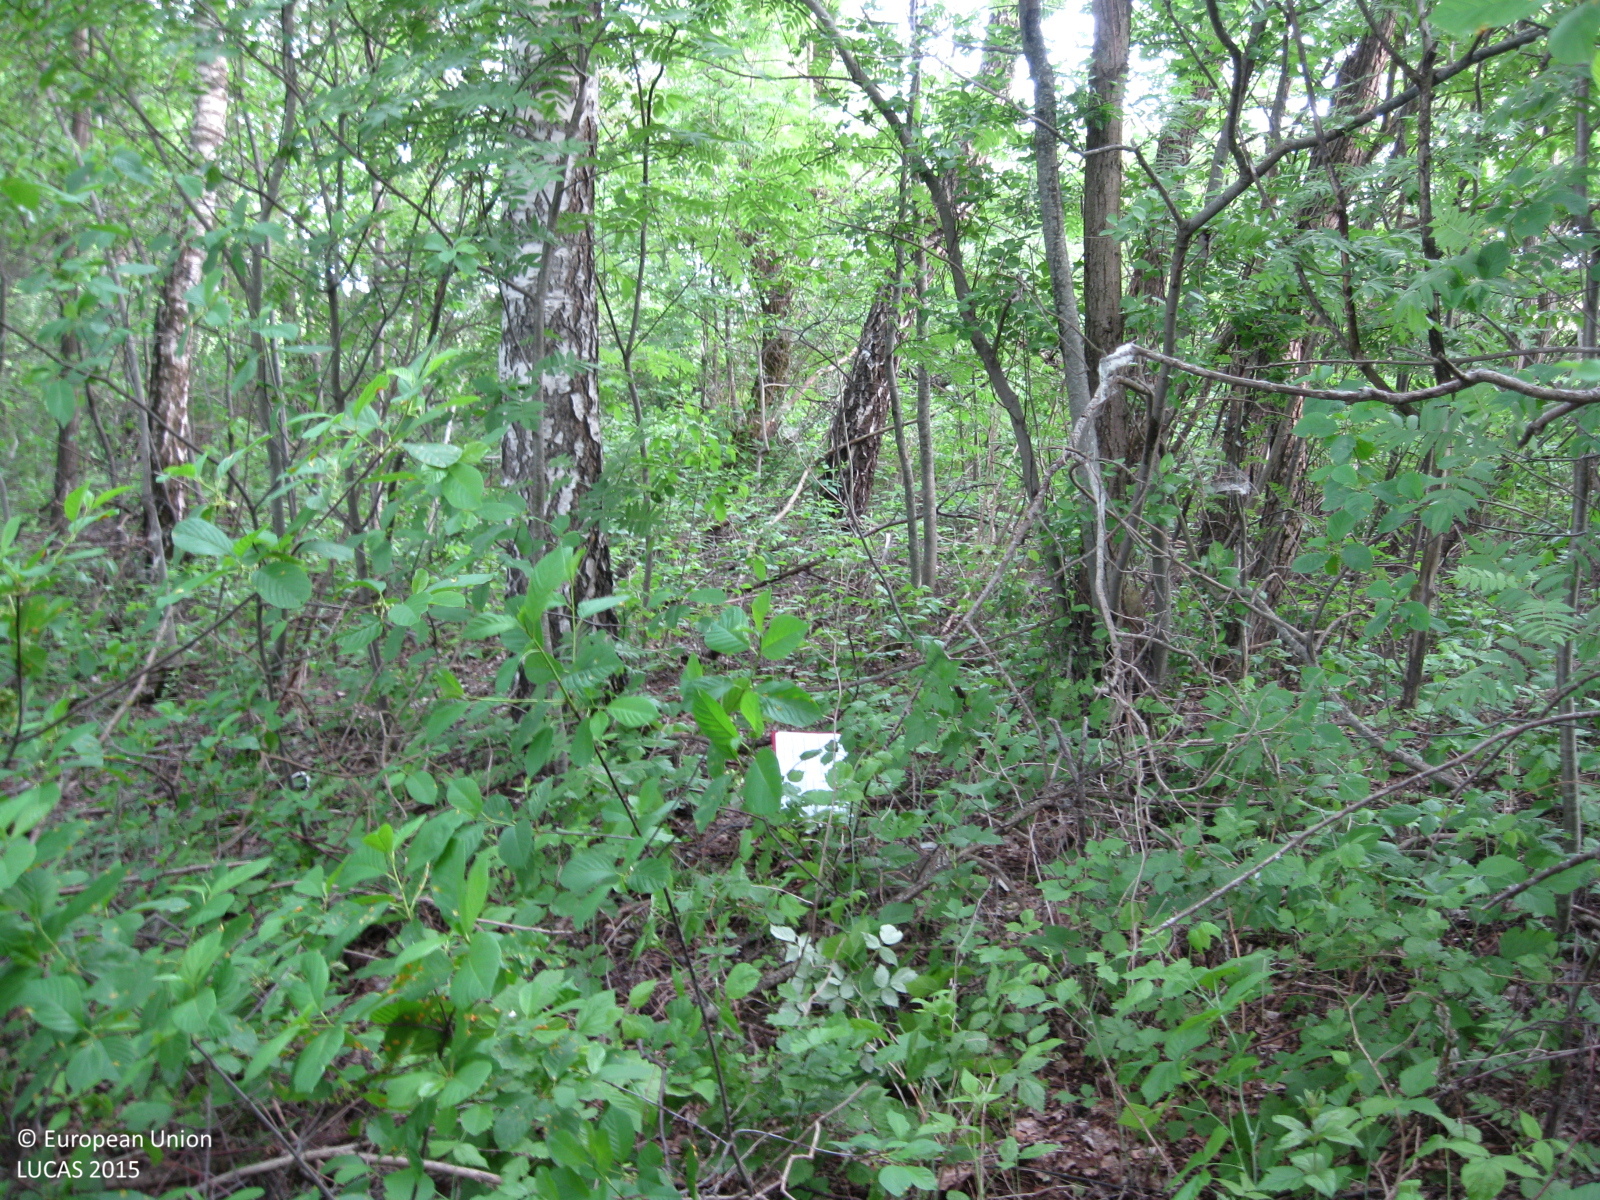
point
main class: Woodland
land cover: Broadleaved woodland
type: non-riverine alder, birch or aspen forest
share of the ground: > 75 %
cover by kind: broadleaved forest trees 75 %, shrubs 10 %, herbaceous plants 10 %, coniferous forest trees 5 %
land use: Semi-natural and natural areas not in use
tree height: > 5 m
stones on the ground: < 10 %
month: June
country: LT
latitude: 55.7262
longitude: 23.6631
